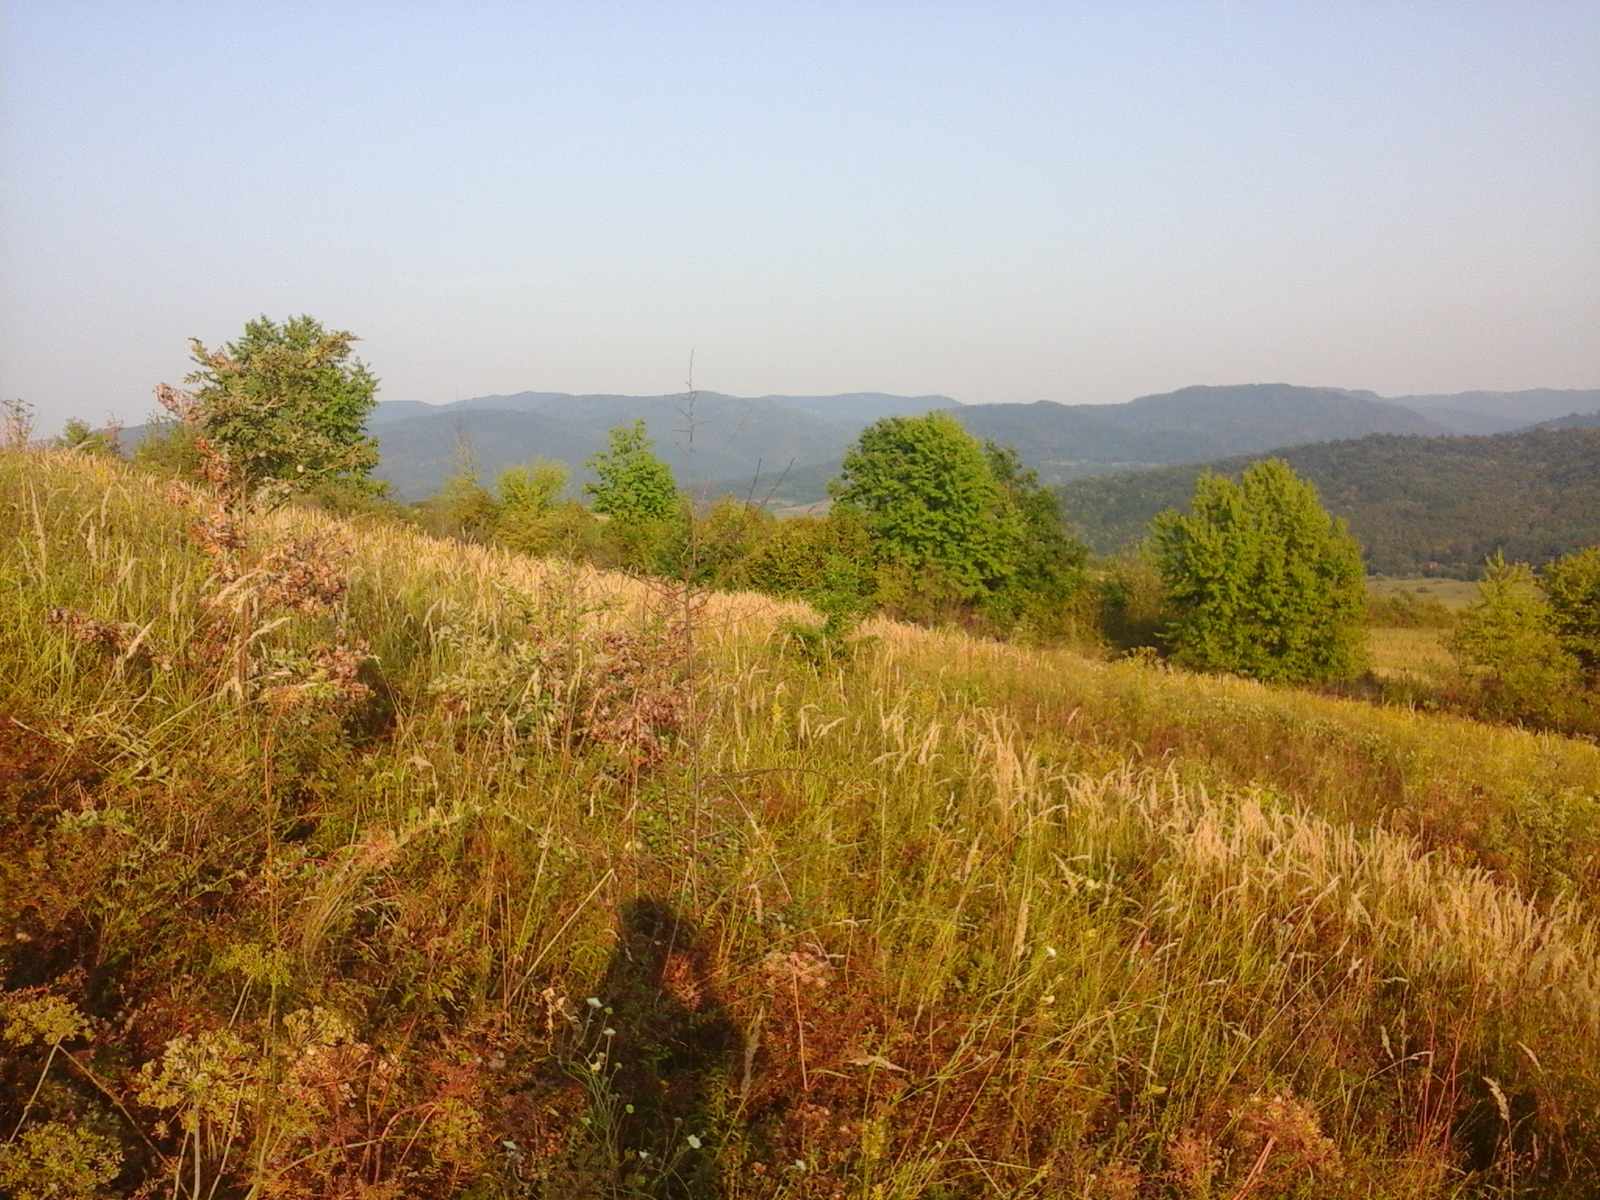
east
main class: Grassland
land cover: Spontaneously vegetated surfaces
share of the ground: > 75 %
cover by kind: herbaceous plants 100 %
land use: Fallow land
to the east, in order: Spontaneously vegetated surfaces; Grassland with sparse tree/shrub cover; Grassland without tree/shrub cover; Maize; Grassland without tree/shrub cover; Spontaneously vegetated surfaces; Grassland without tree/shrub cover; Grassland with sparse tree/shrub cover
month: August
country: RO
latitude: 46.2389
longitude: 22.3022
